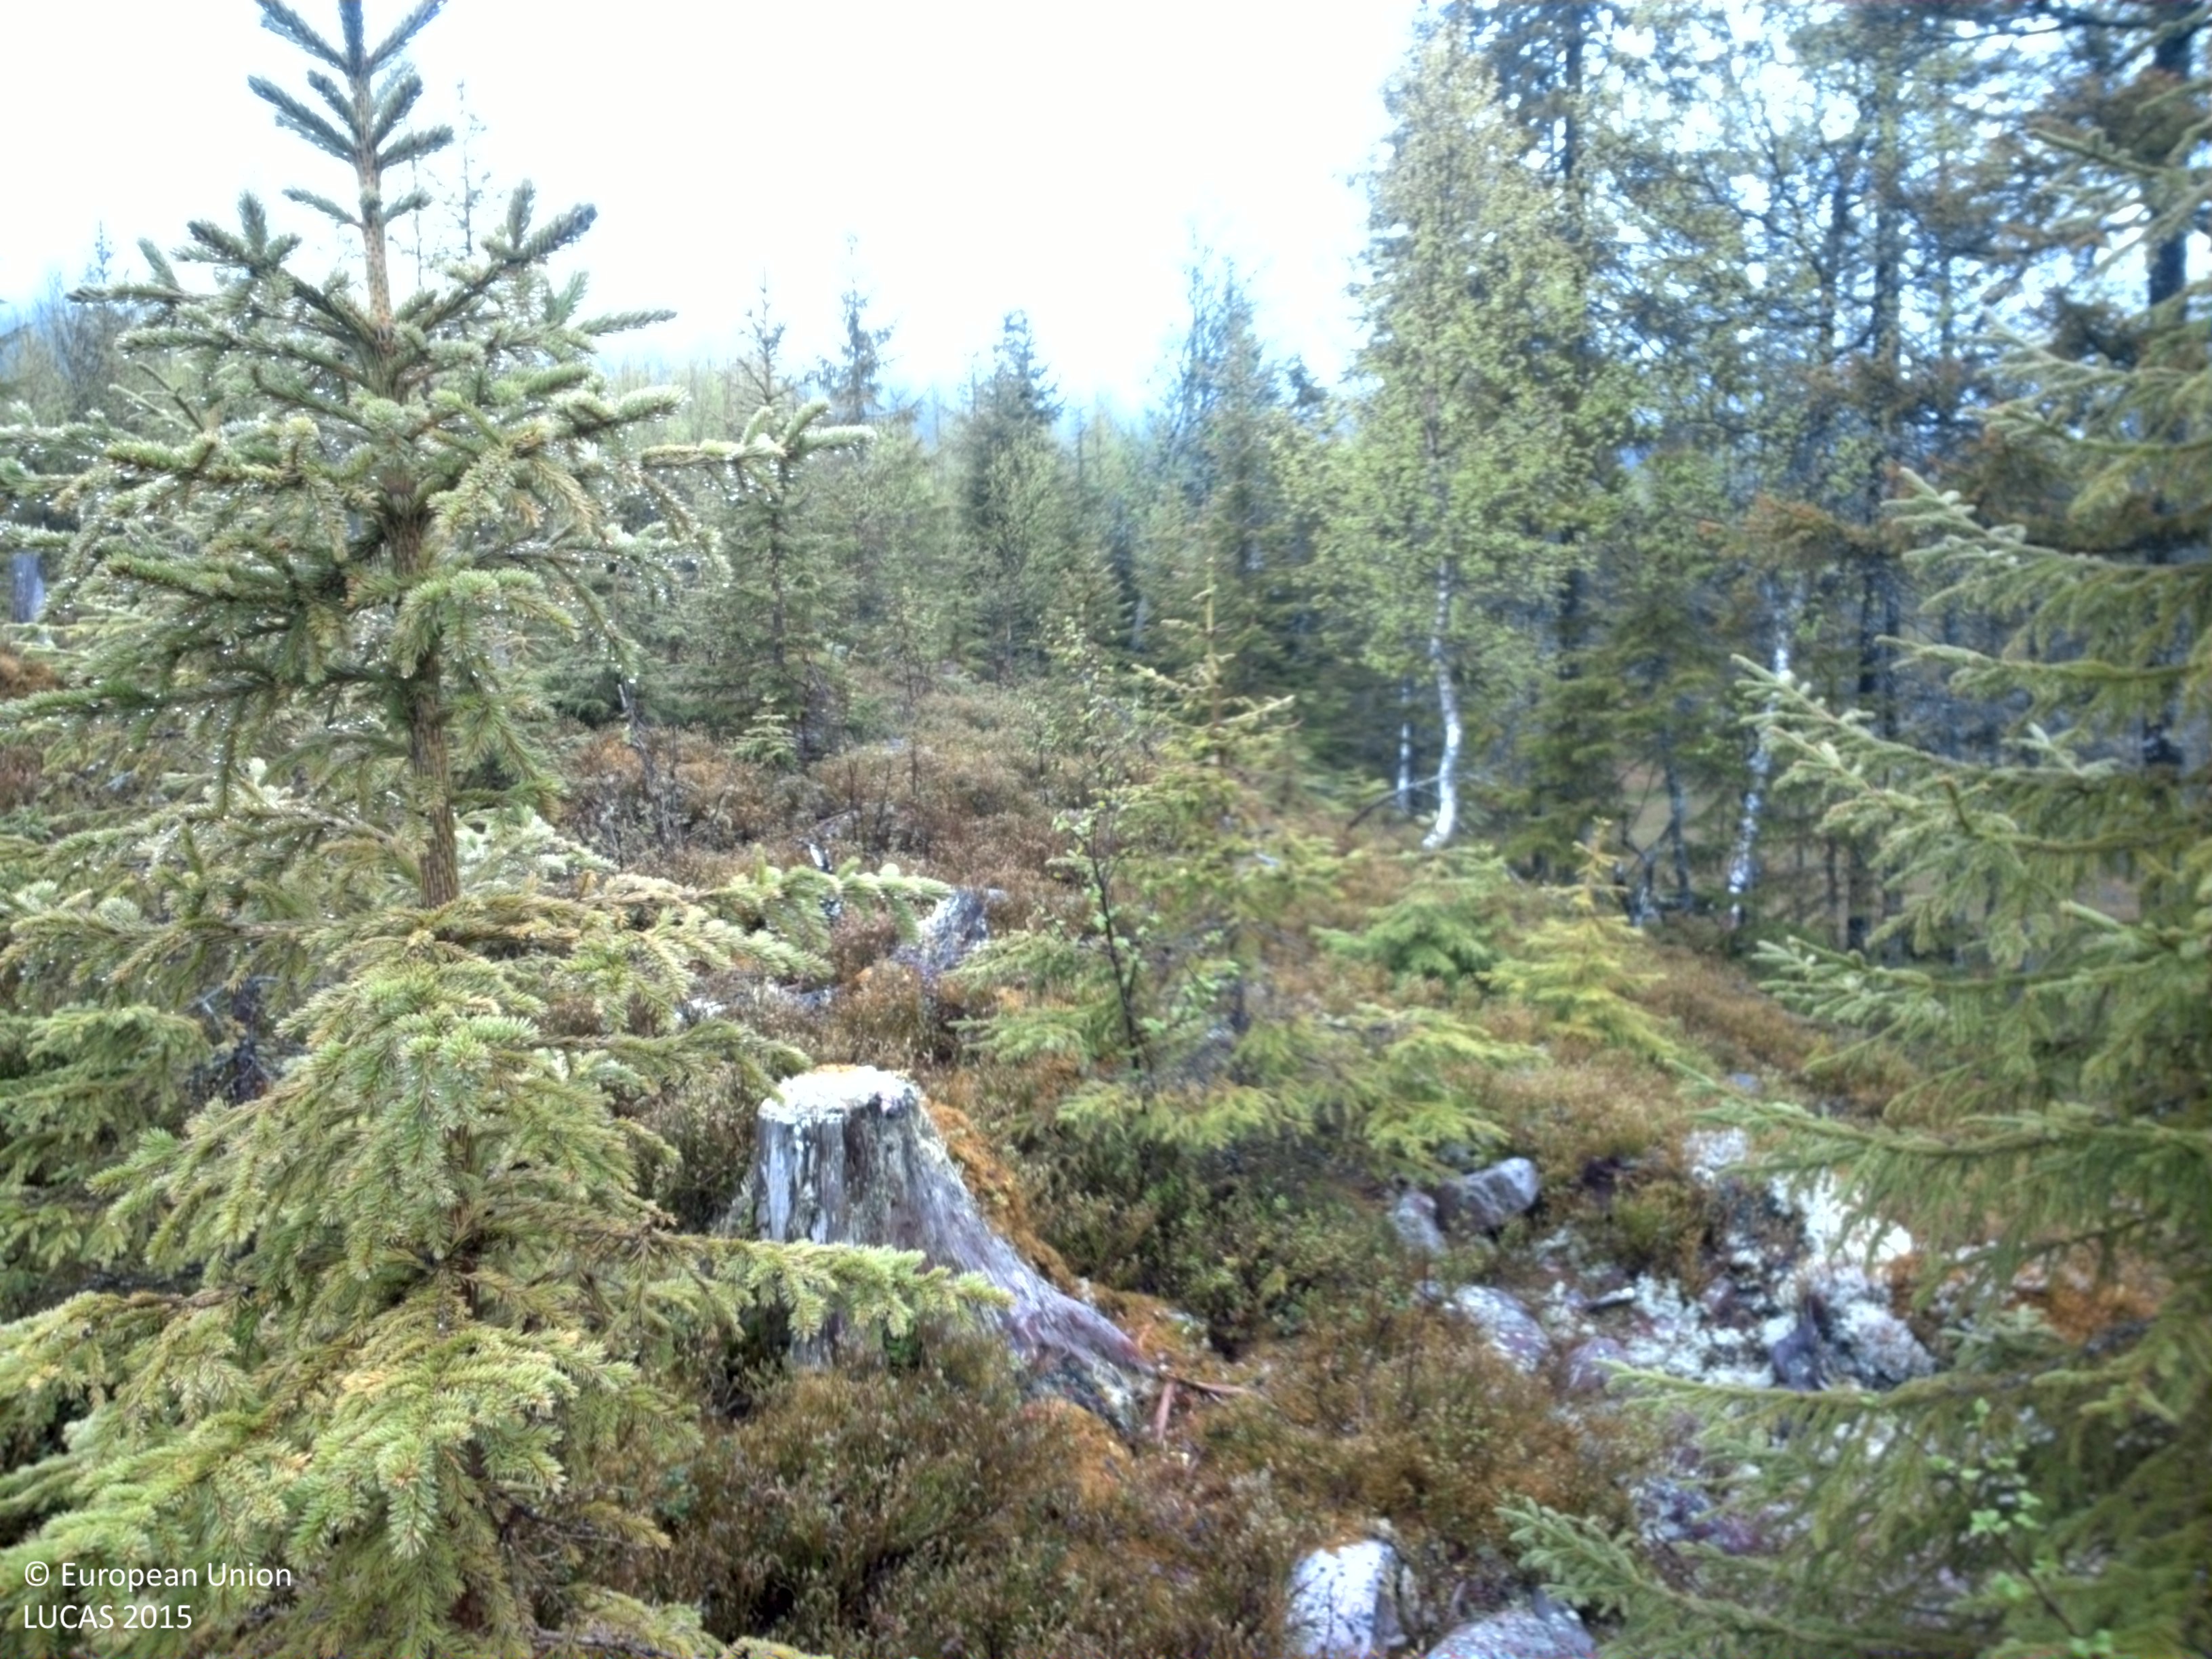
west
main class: Woodland
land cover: Spruce dominated mixed woodland
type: boreal forest
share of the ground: 50 - 75 %
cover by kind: coniferous forest trees 40 %, broadleaved forest trees 25 %, shrubs 20 %, lichens and mosses 10 %, herbaceous plants 5 %
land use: Forestry
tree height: < 5 m
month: June
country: SE
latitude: 61.1167
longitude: 13.2367
